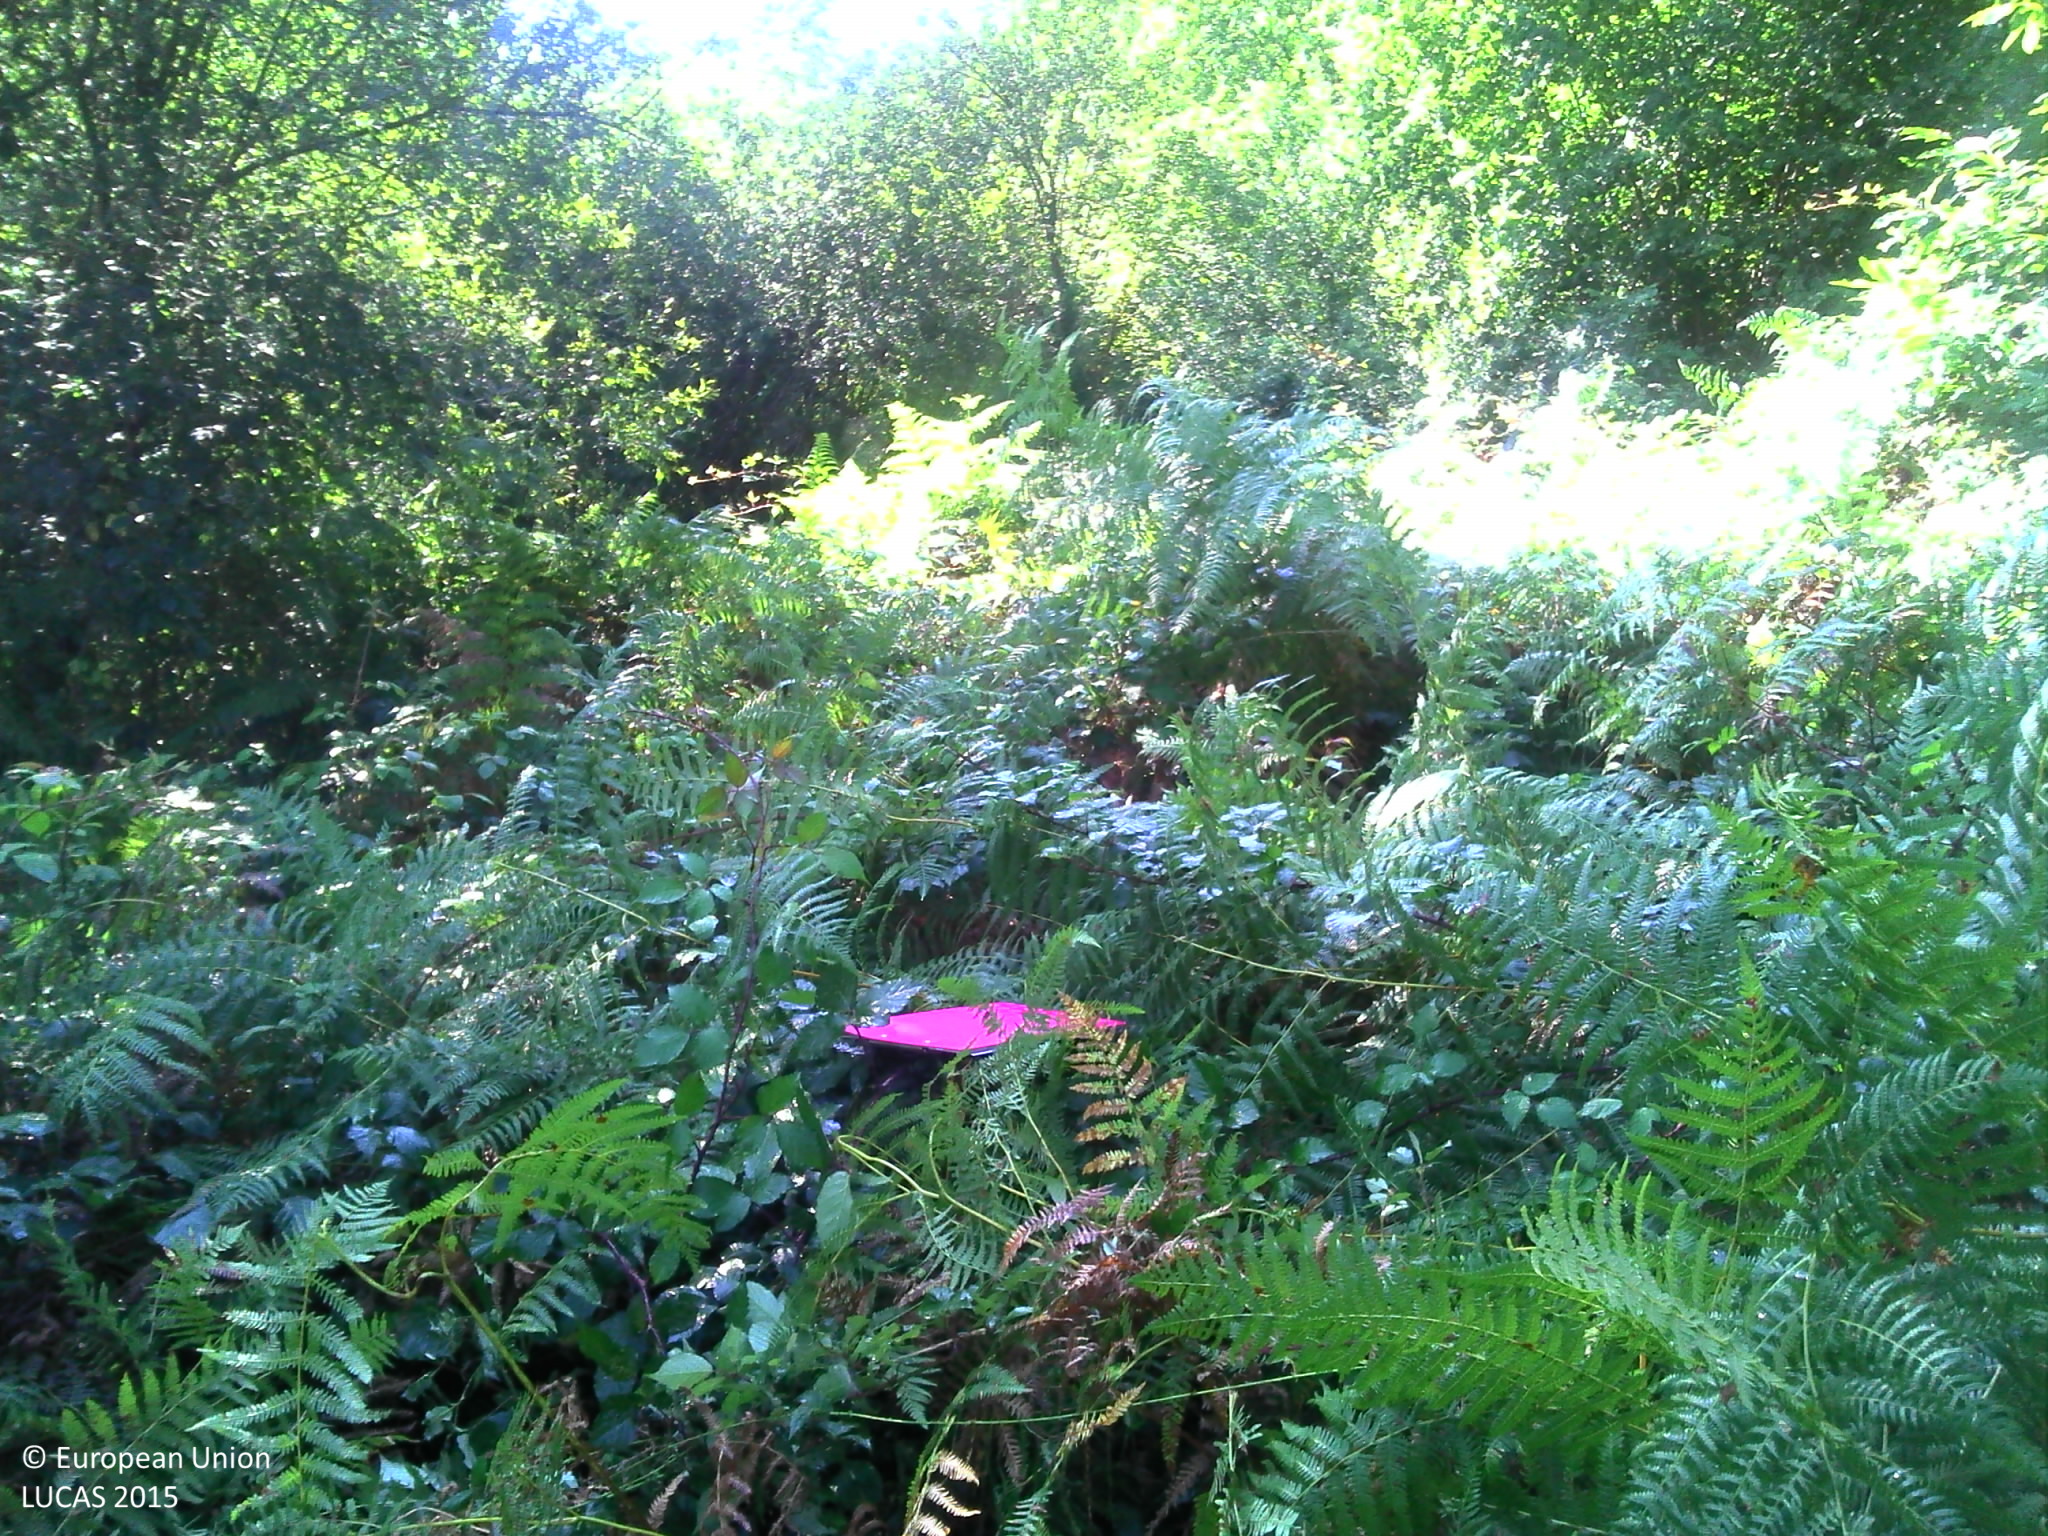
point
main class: Shrubland
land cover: Shrubland with sparse tree cover
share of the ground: > 75 %
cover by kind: shrubs 55 %, herbaceous plants 40 %, broadleaved forest trees 5 %
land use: Semi-natural and natural areas not in use
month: September
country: FR
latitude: 43.1033
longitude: -0.8839
